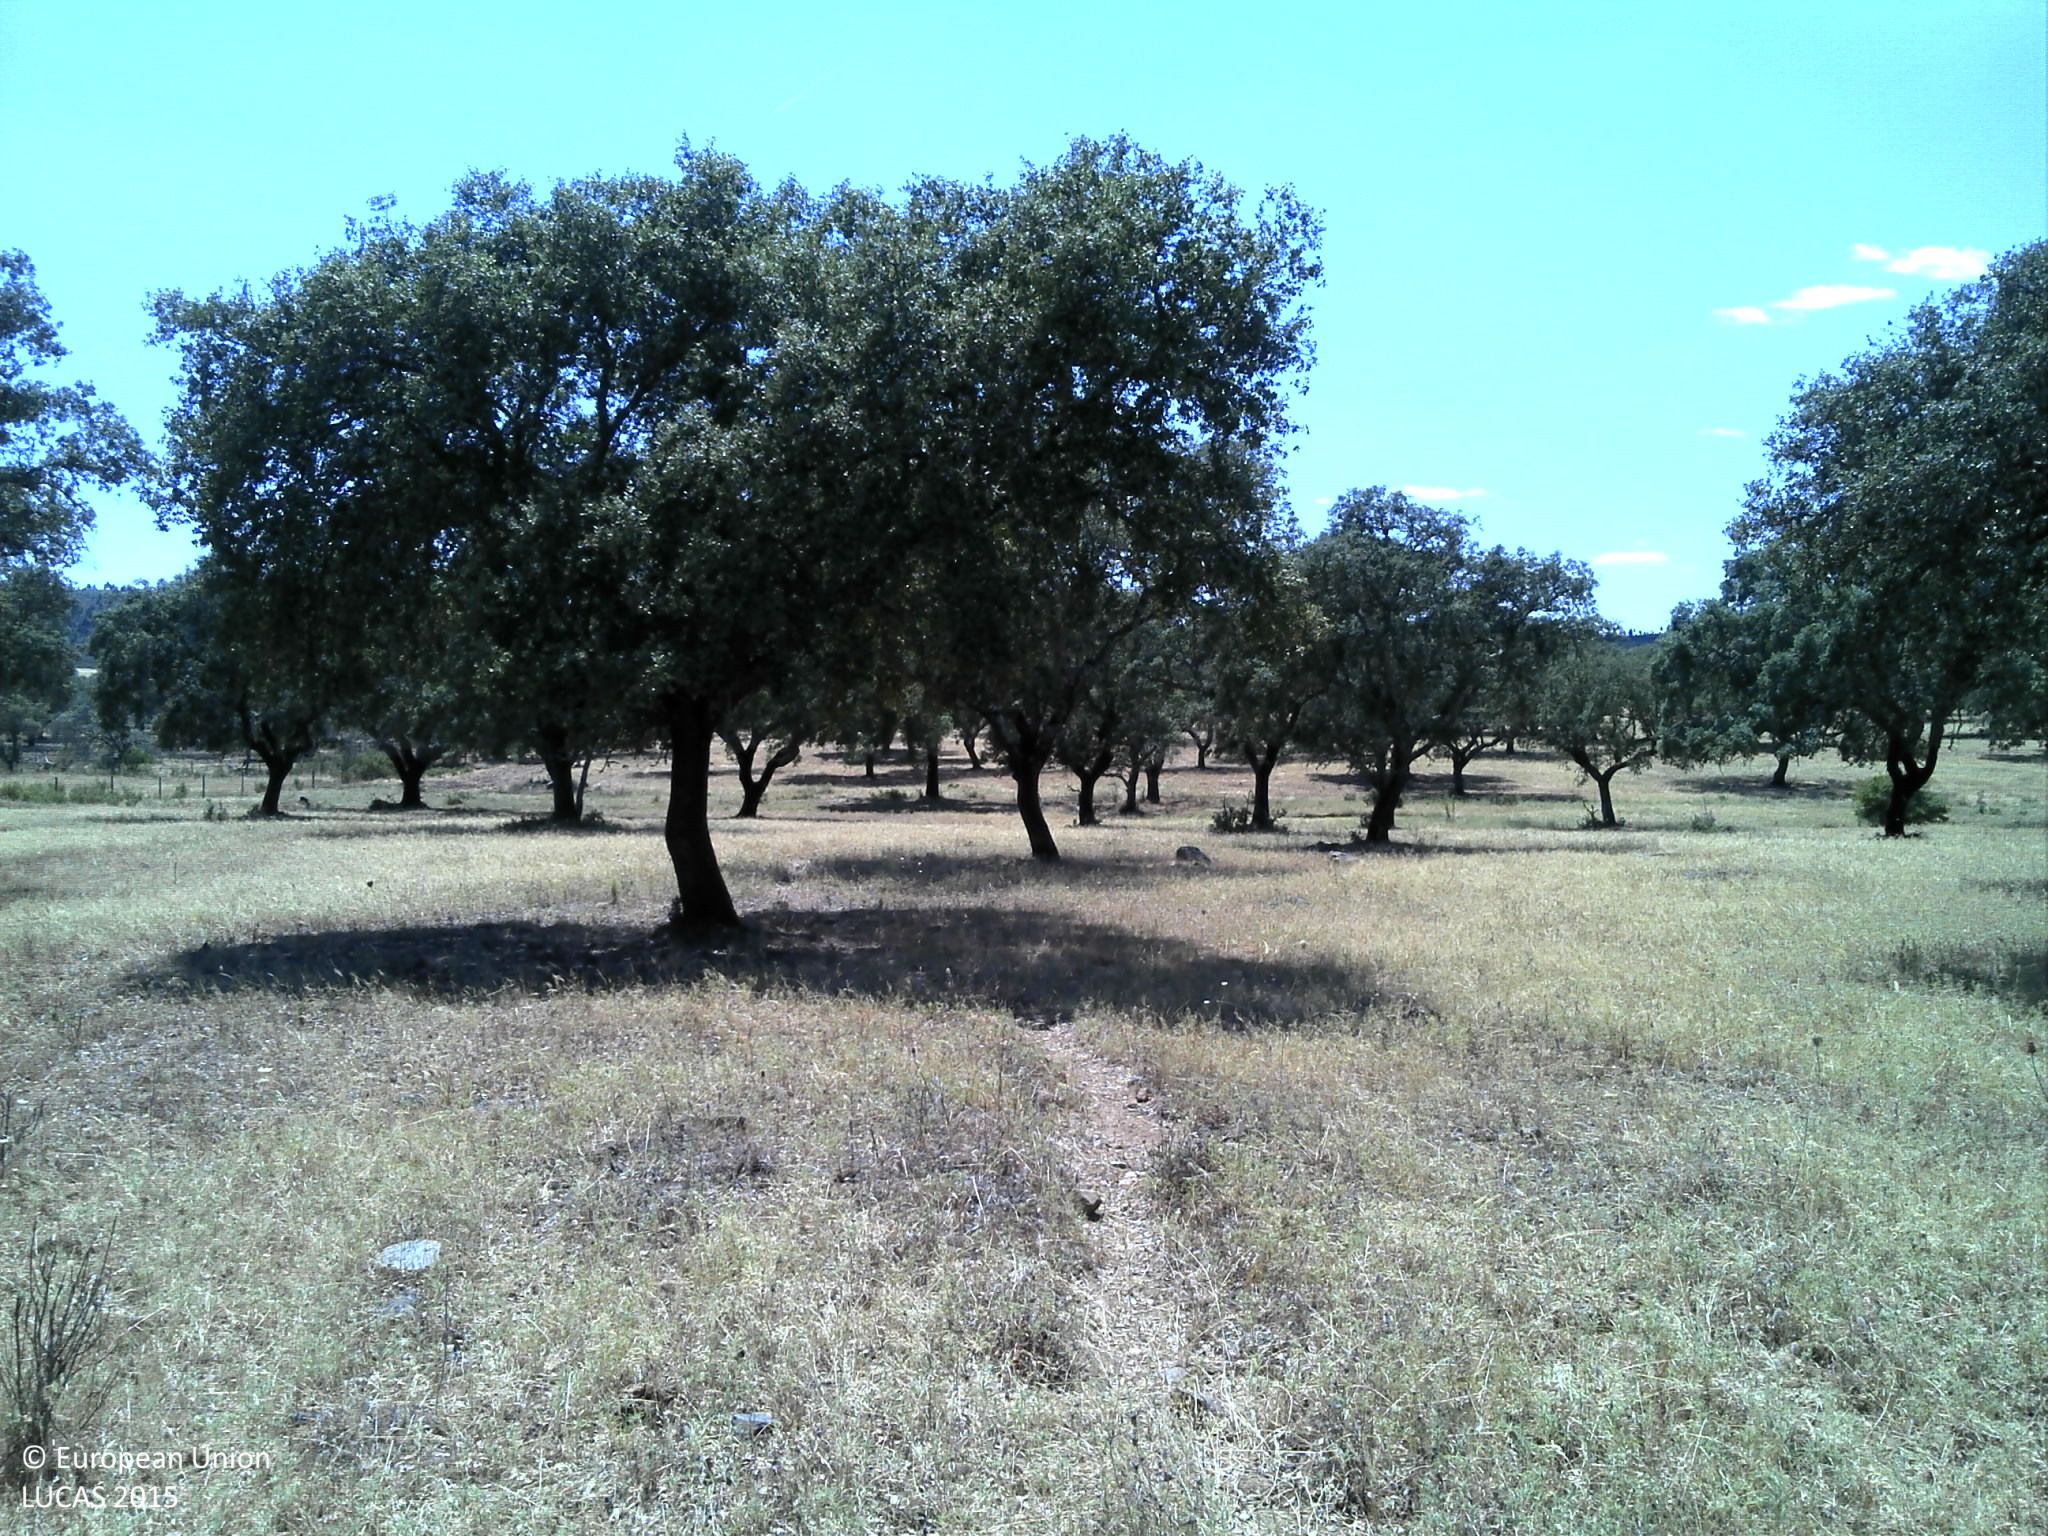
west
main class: Woodland
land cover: Broadleaved woodland
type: broadleaved evergreen forest
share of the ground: 10 - 25 %
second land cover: Grassland without tree/shrub cover
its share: 25 - 50 %
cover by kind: unconsolidated bare surface 50 %, broadleaved forest trees 25 %, herbaceous plants 25 %
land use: Forestry
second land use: Agriculture (excluding fallow land and kitchen gardens)
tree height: > 5 m
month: June
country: PT
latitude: 38.3537
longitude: -8.1560
